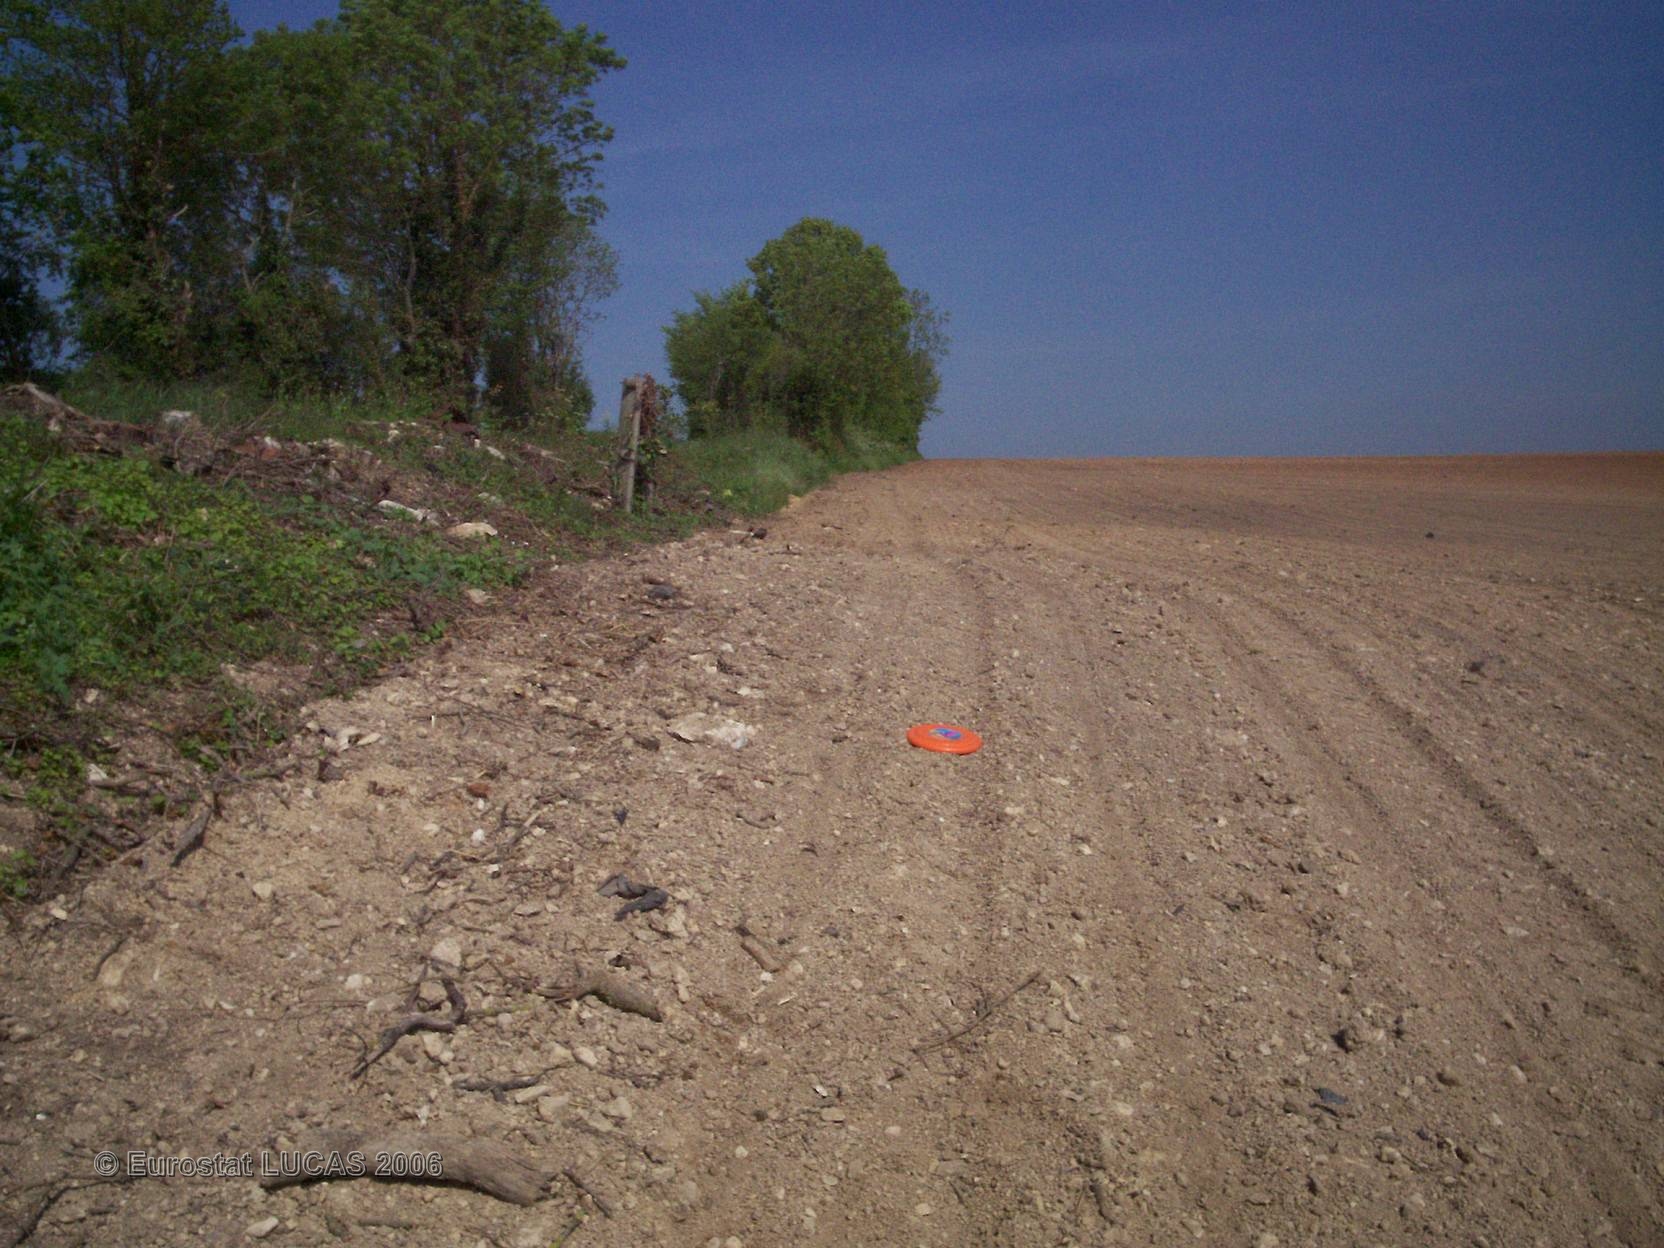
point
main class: Cropland
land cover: Sunflower
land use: Agriculture (excluding fallow land and kitchen gardens)
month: May
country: FR
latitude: 46.2026
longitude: -0.2479
